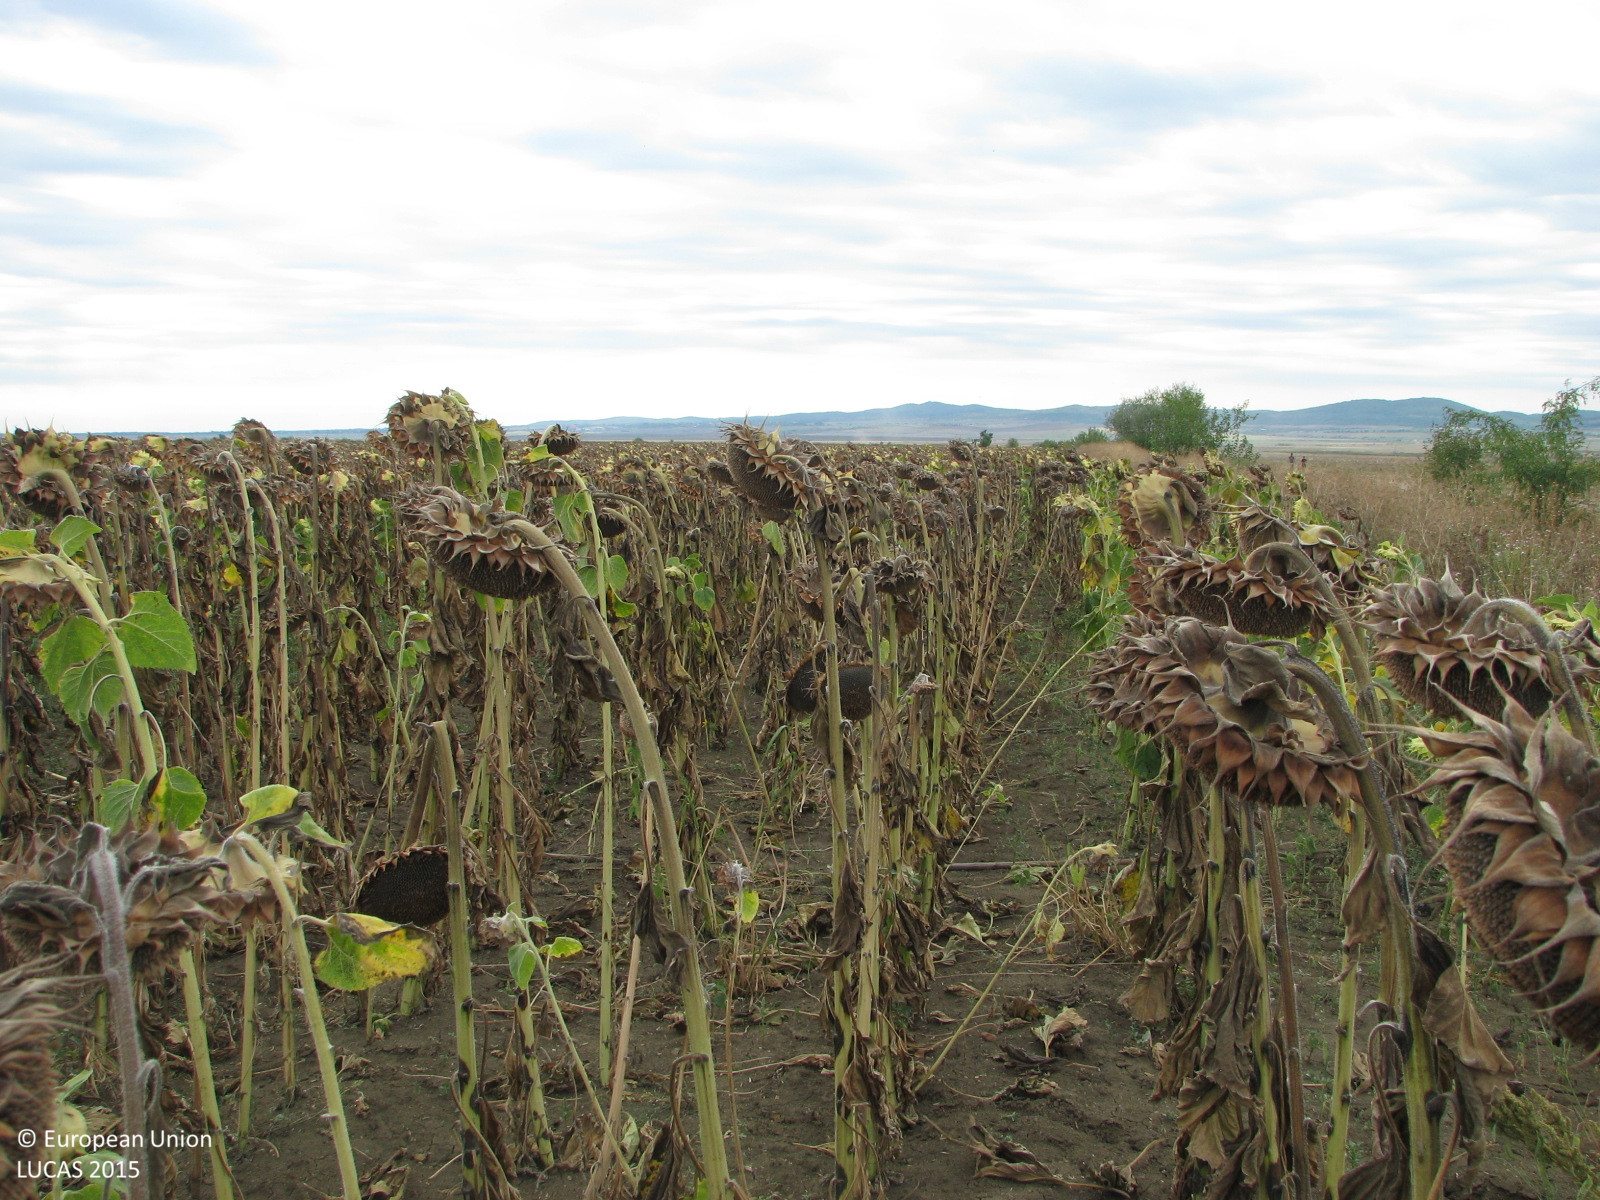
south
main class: Cropland
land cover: Sunflower
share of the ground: > 75 %
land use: Agriculture (excluding fallow land and kitchen gardens)
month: September
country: BG
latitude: 42.5157
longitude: 26.0886
